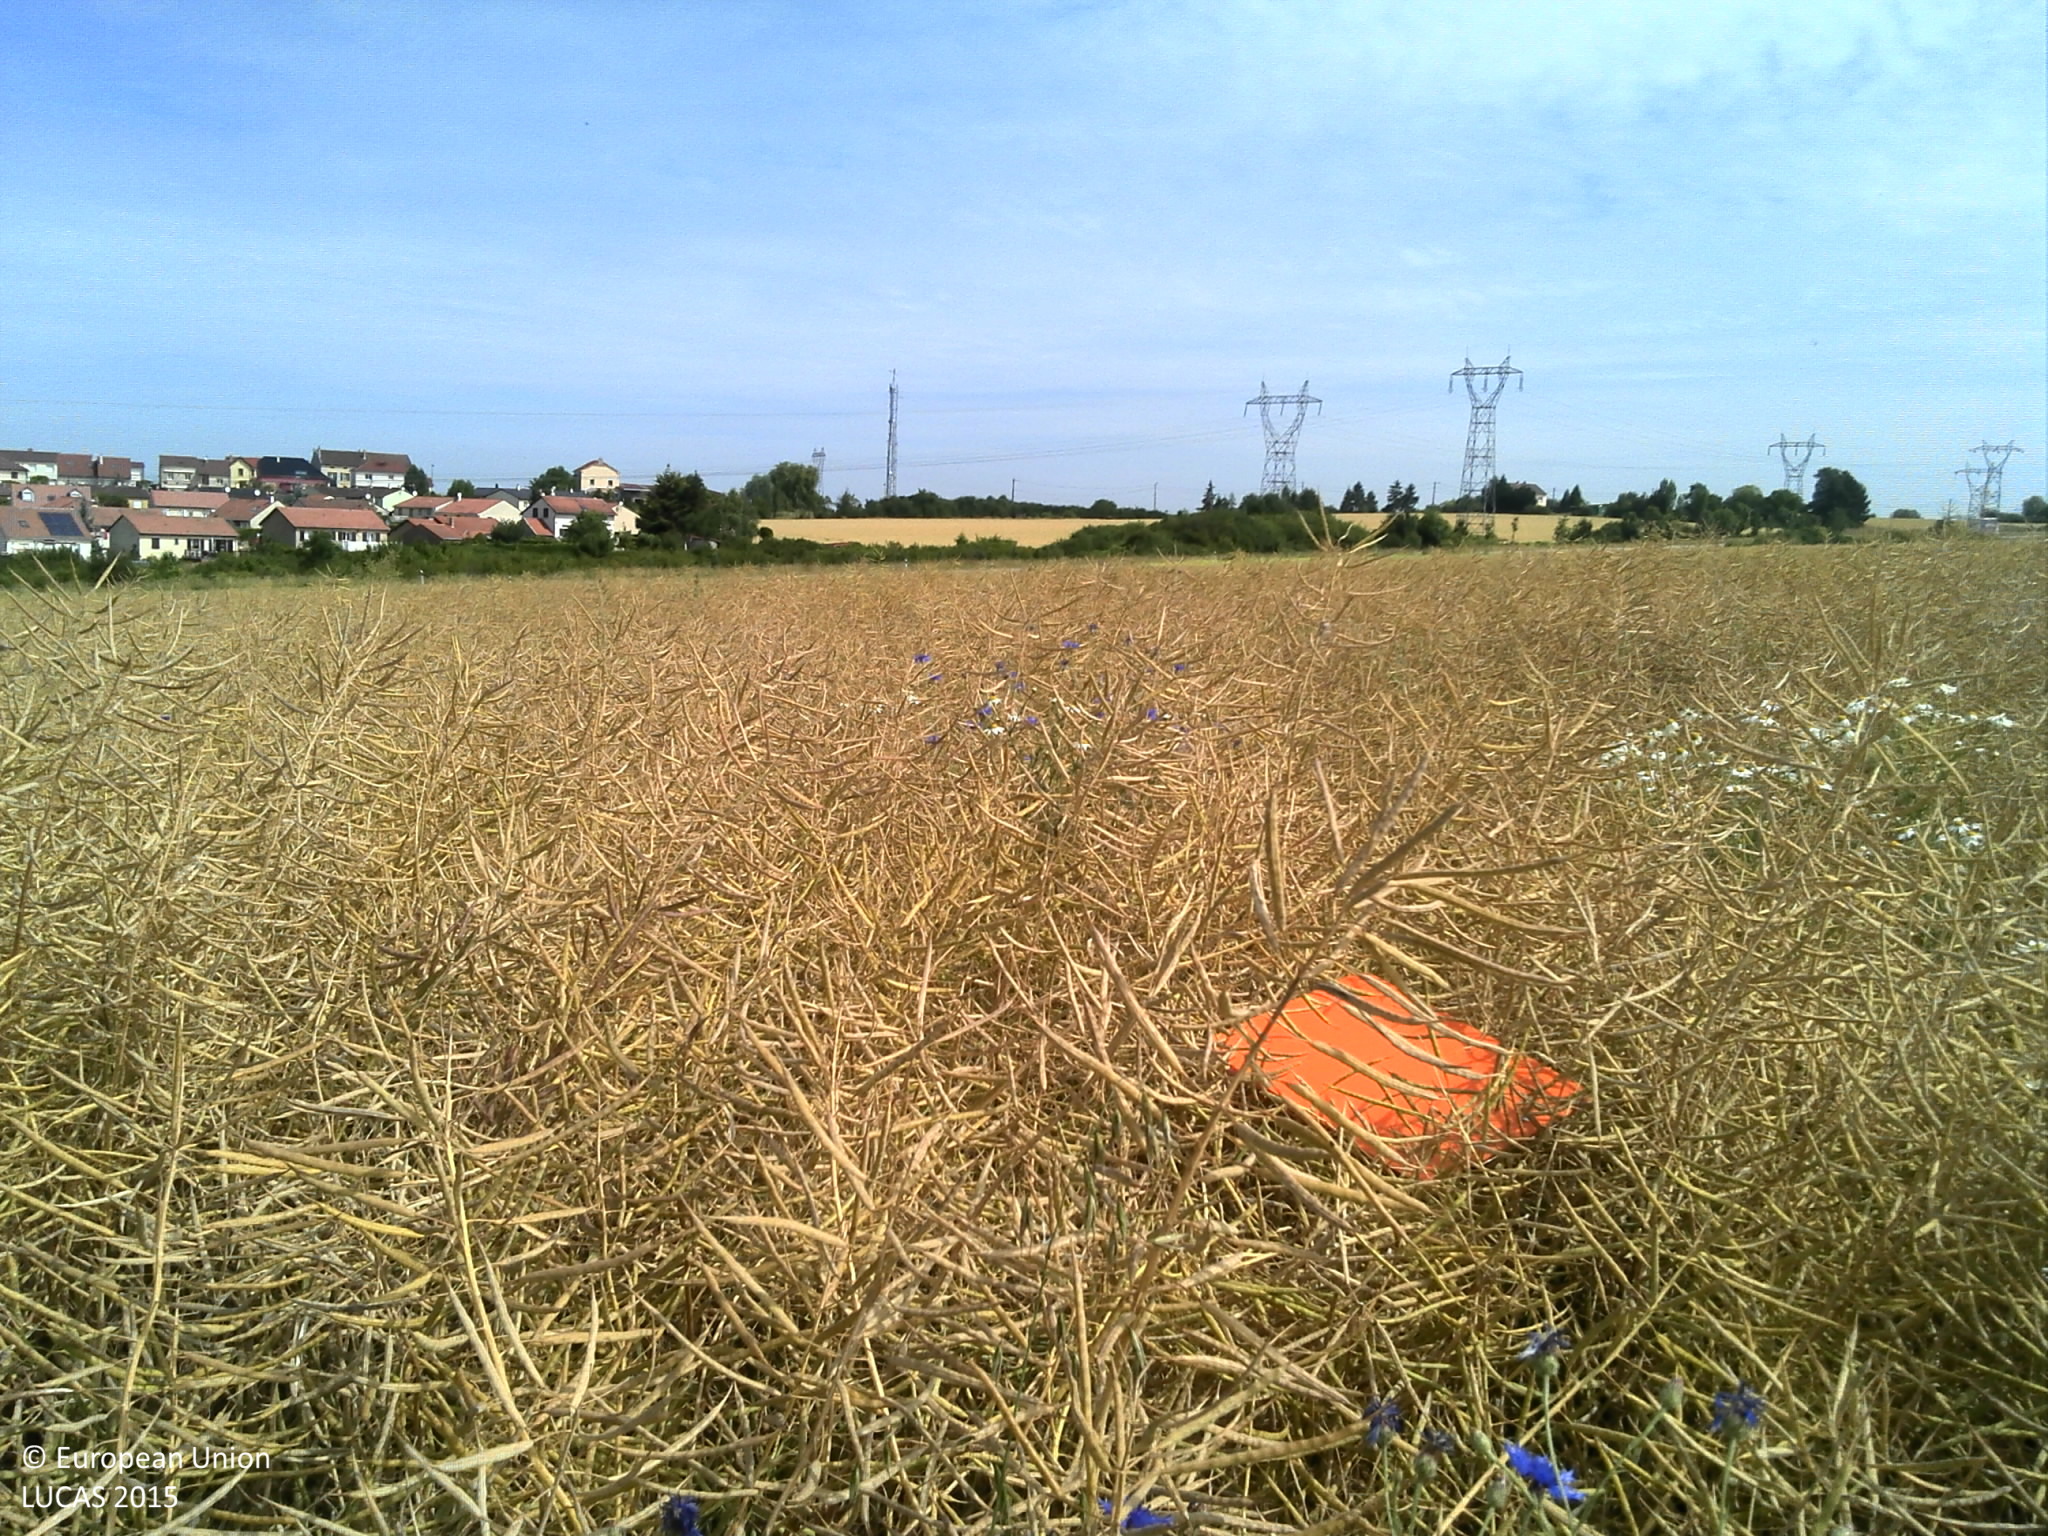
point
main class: Cropland
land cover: Rape and turnip rape
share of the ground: > 75 %
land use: Agriculture (excluding fallow land and kitchen gardens)
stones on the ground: > 50 %
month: June
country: FR
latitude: 49.2149
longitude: 6.0320
